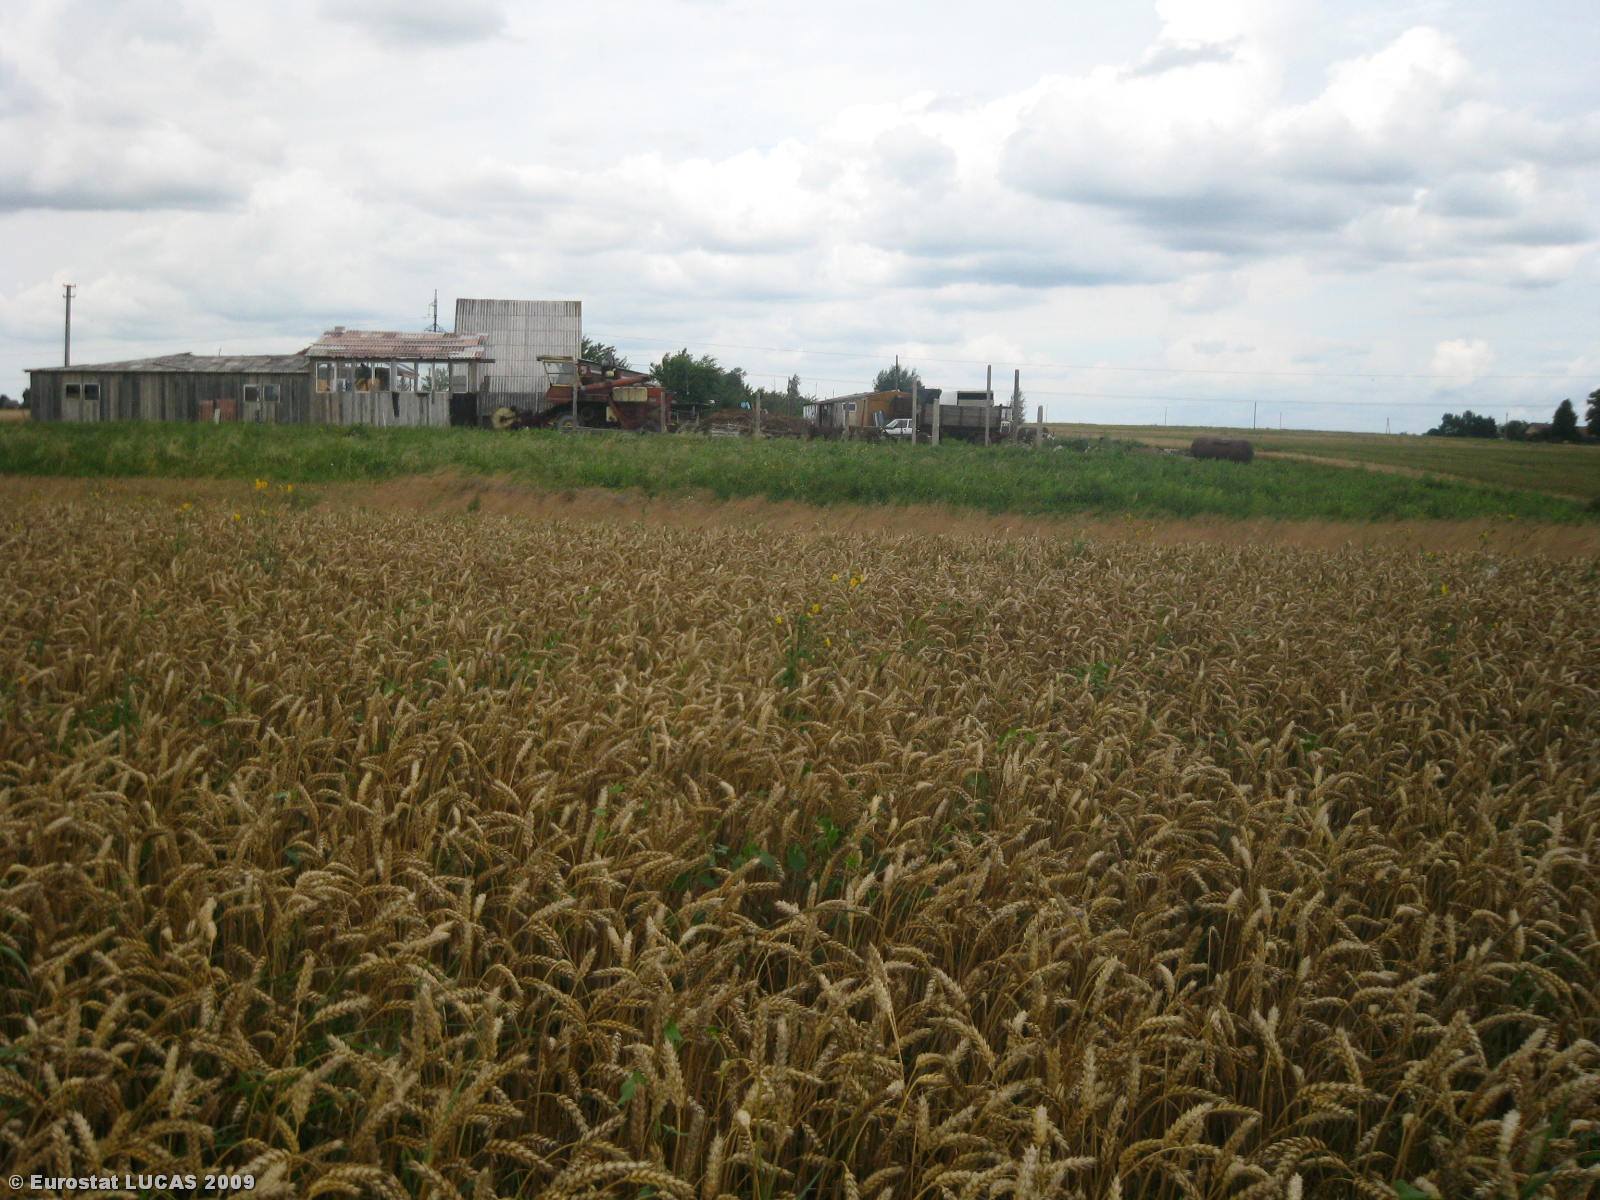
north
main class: Cropland
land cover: Common wheat
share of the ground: > 75 %
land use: Agriculture (excluding fallow land and kitchen gardens)
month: July
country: LT
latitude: 55.0338
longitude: 23.6487
